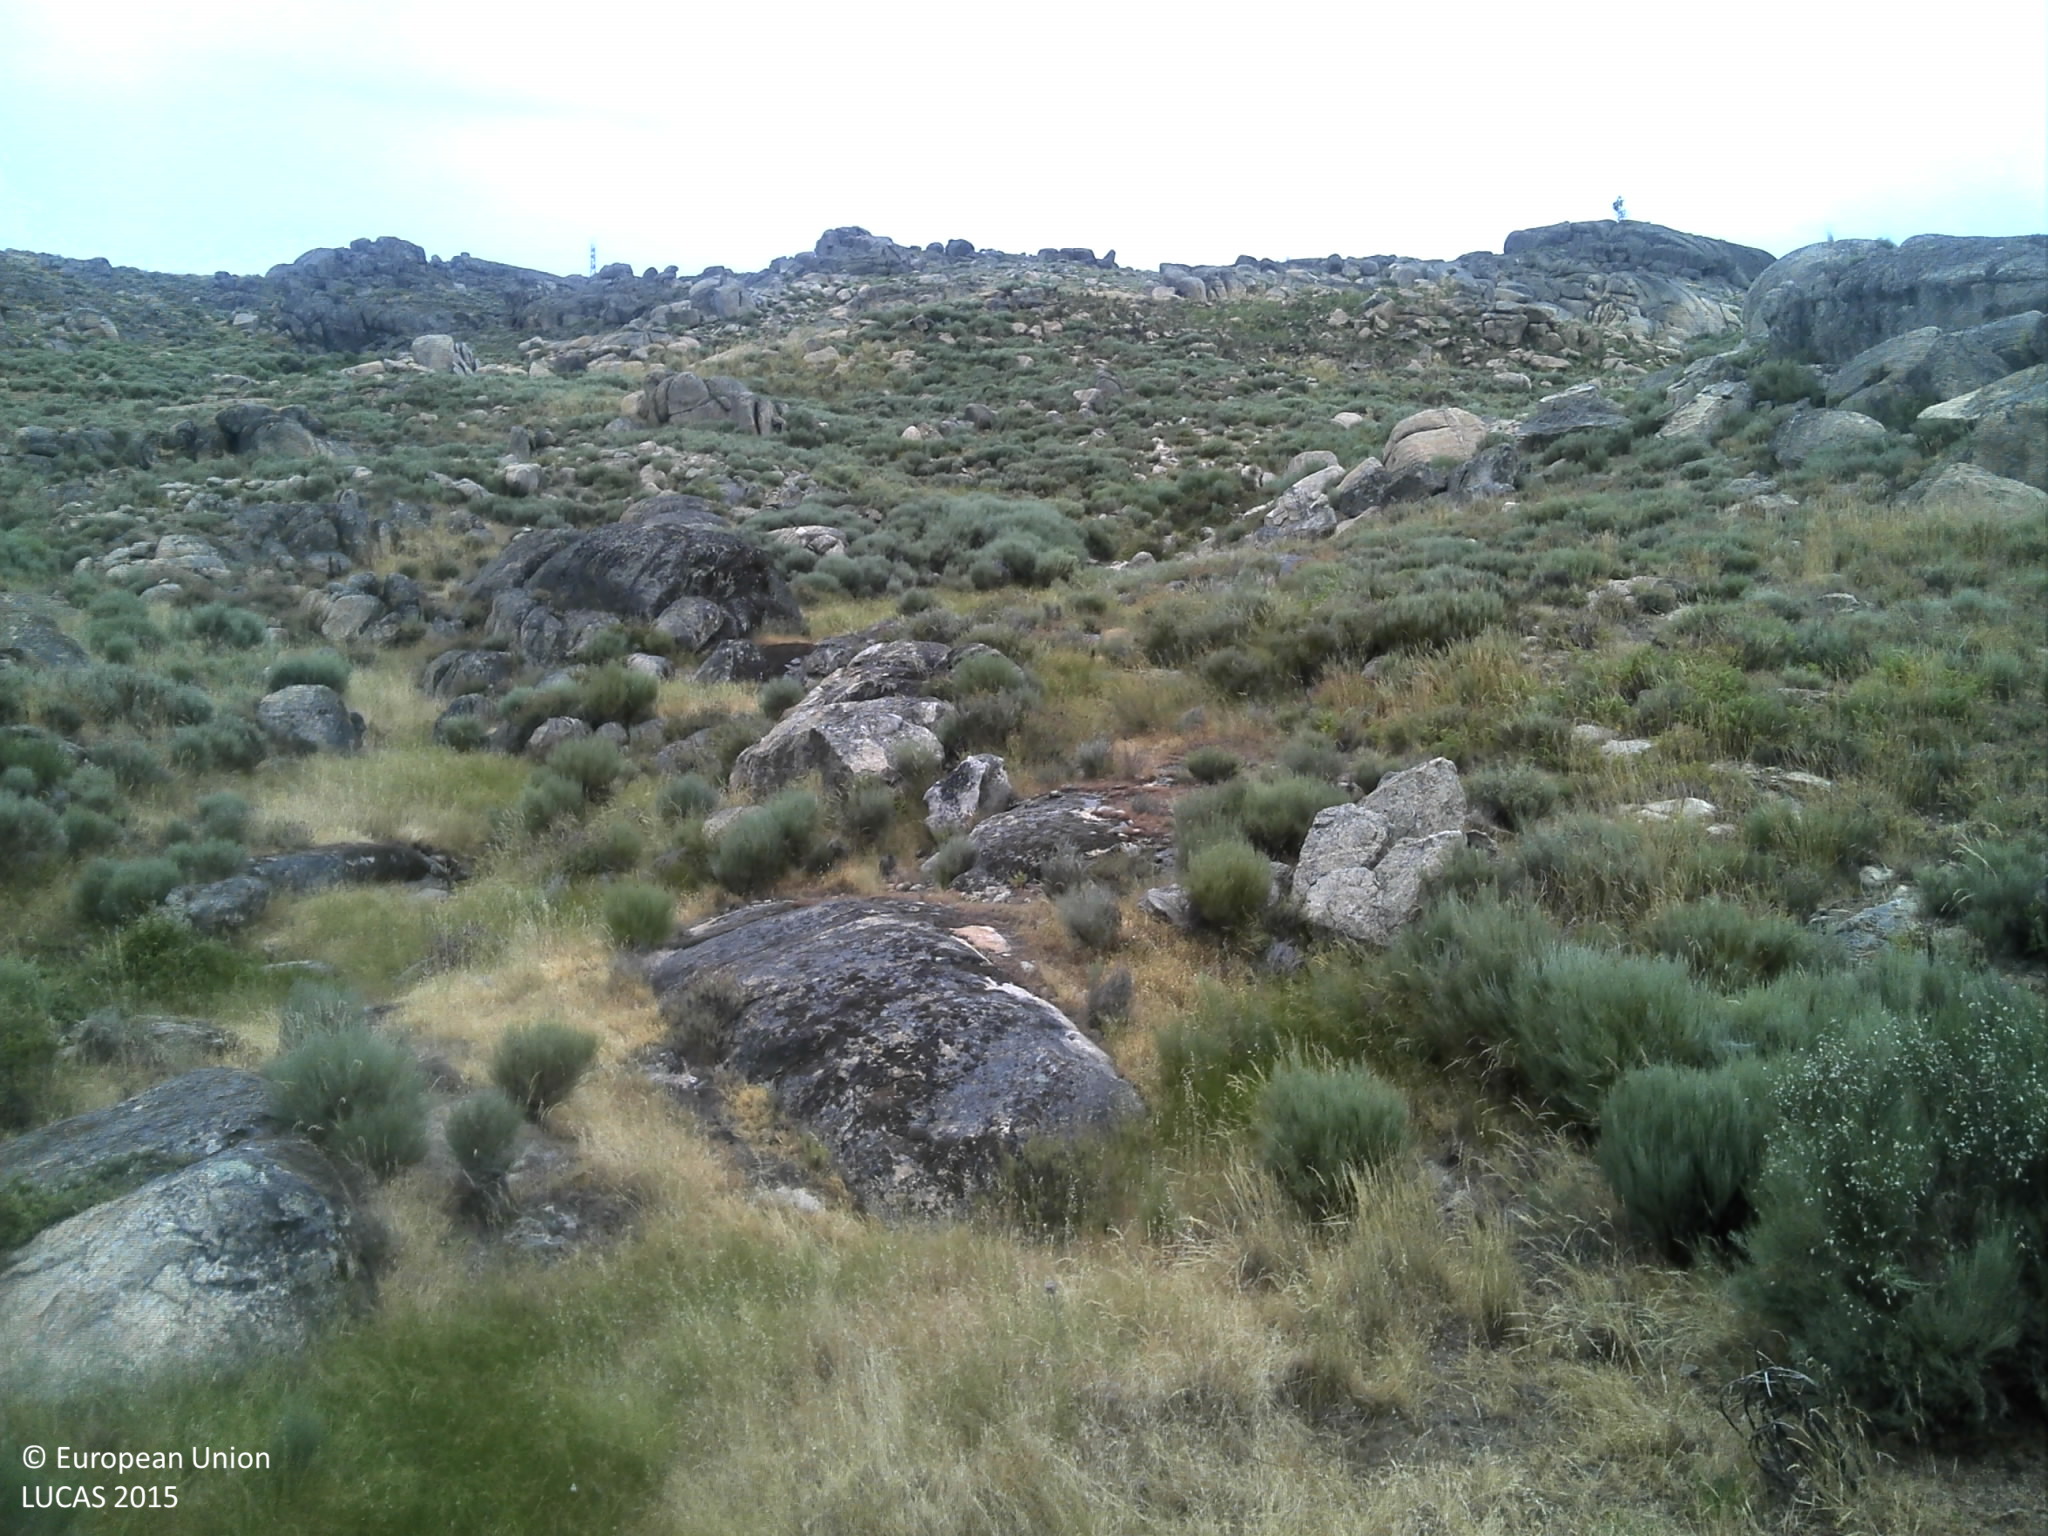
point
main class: Shrubland
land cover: Shrubland without tree cover
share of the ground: 25 - 50 %
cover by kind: shrubs 45 %, unconsolidated bare surface 25 %, herbaceous plants 5 %
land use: Semi-natural and natural areas not in use
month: June
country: PT
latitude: 40.3433
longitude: -7.1823
